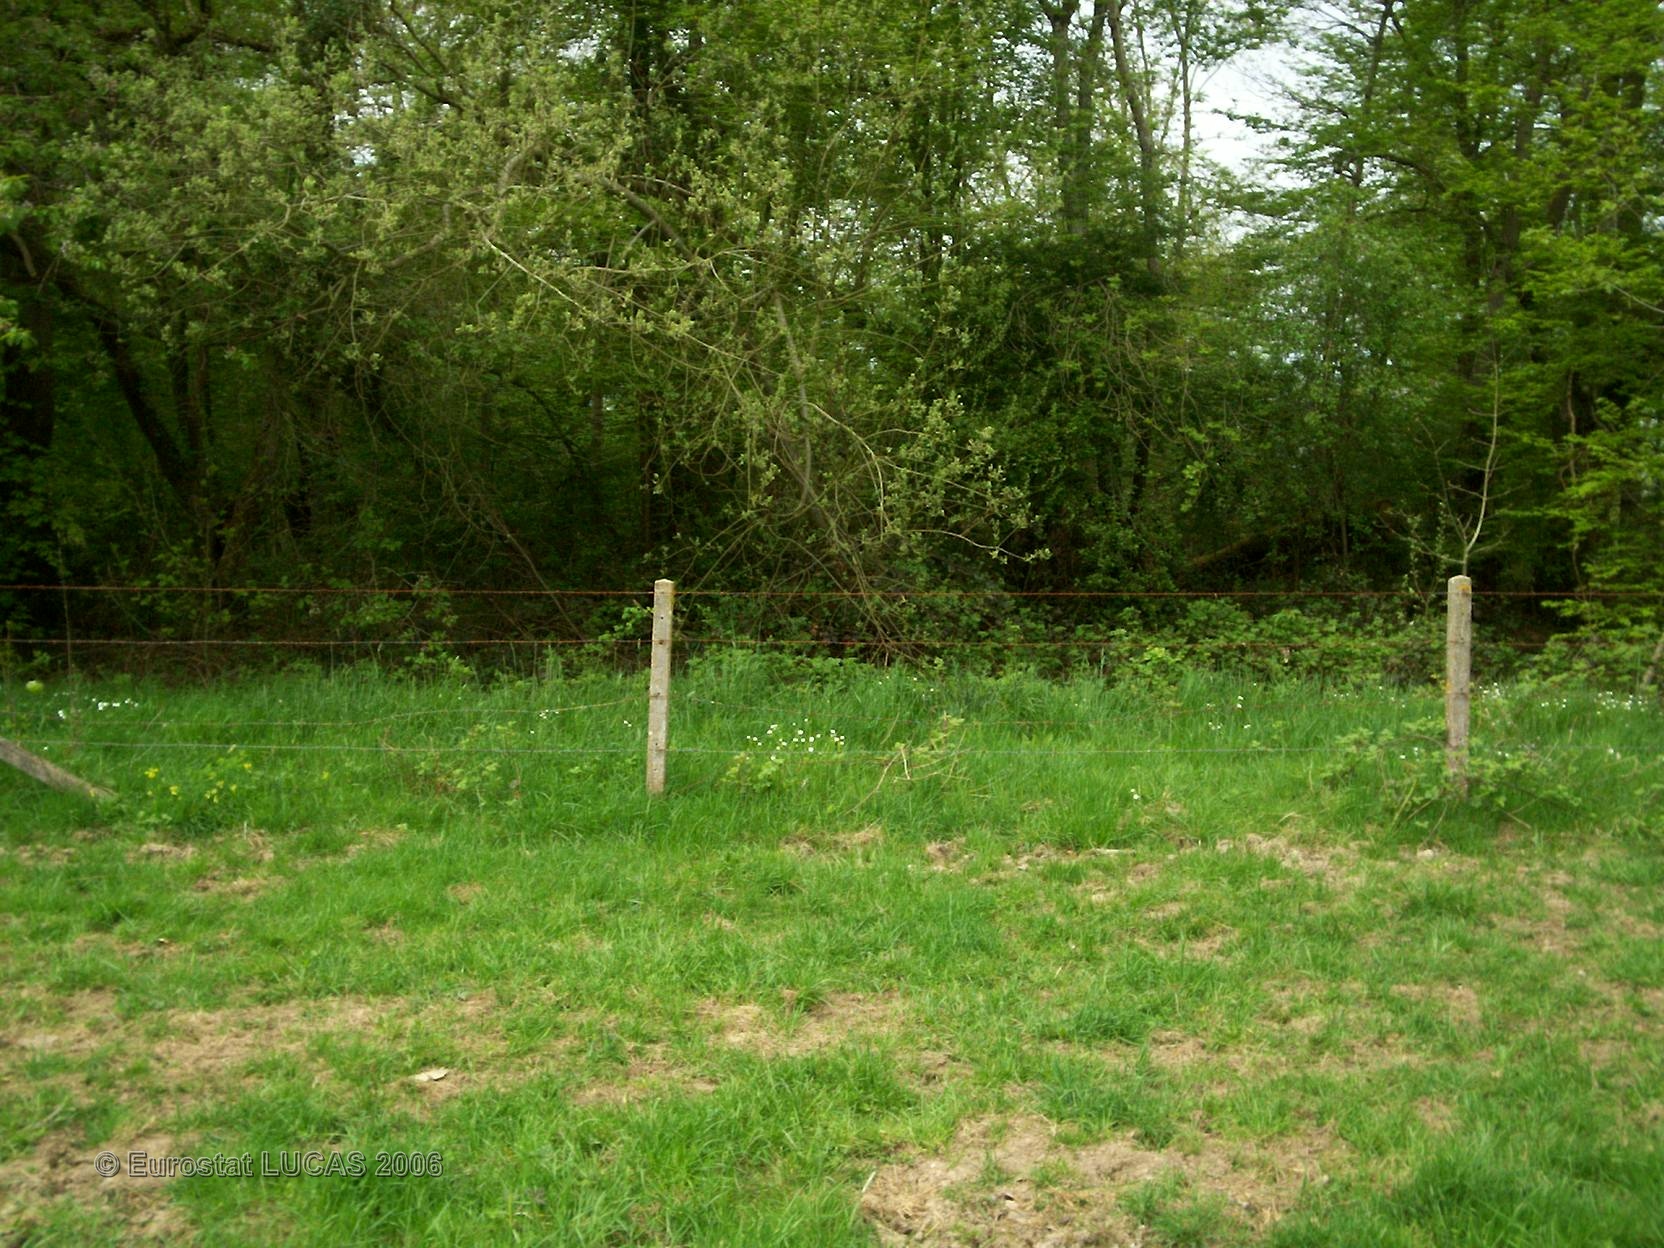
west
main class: Grassland
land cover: Grassland without tree/shrub cover
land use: Agriculture (excluding fallow land and kitchen gardens)
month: May
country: FR
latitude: 48.9034
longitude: 0.5478
